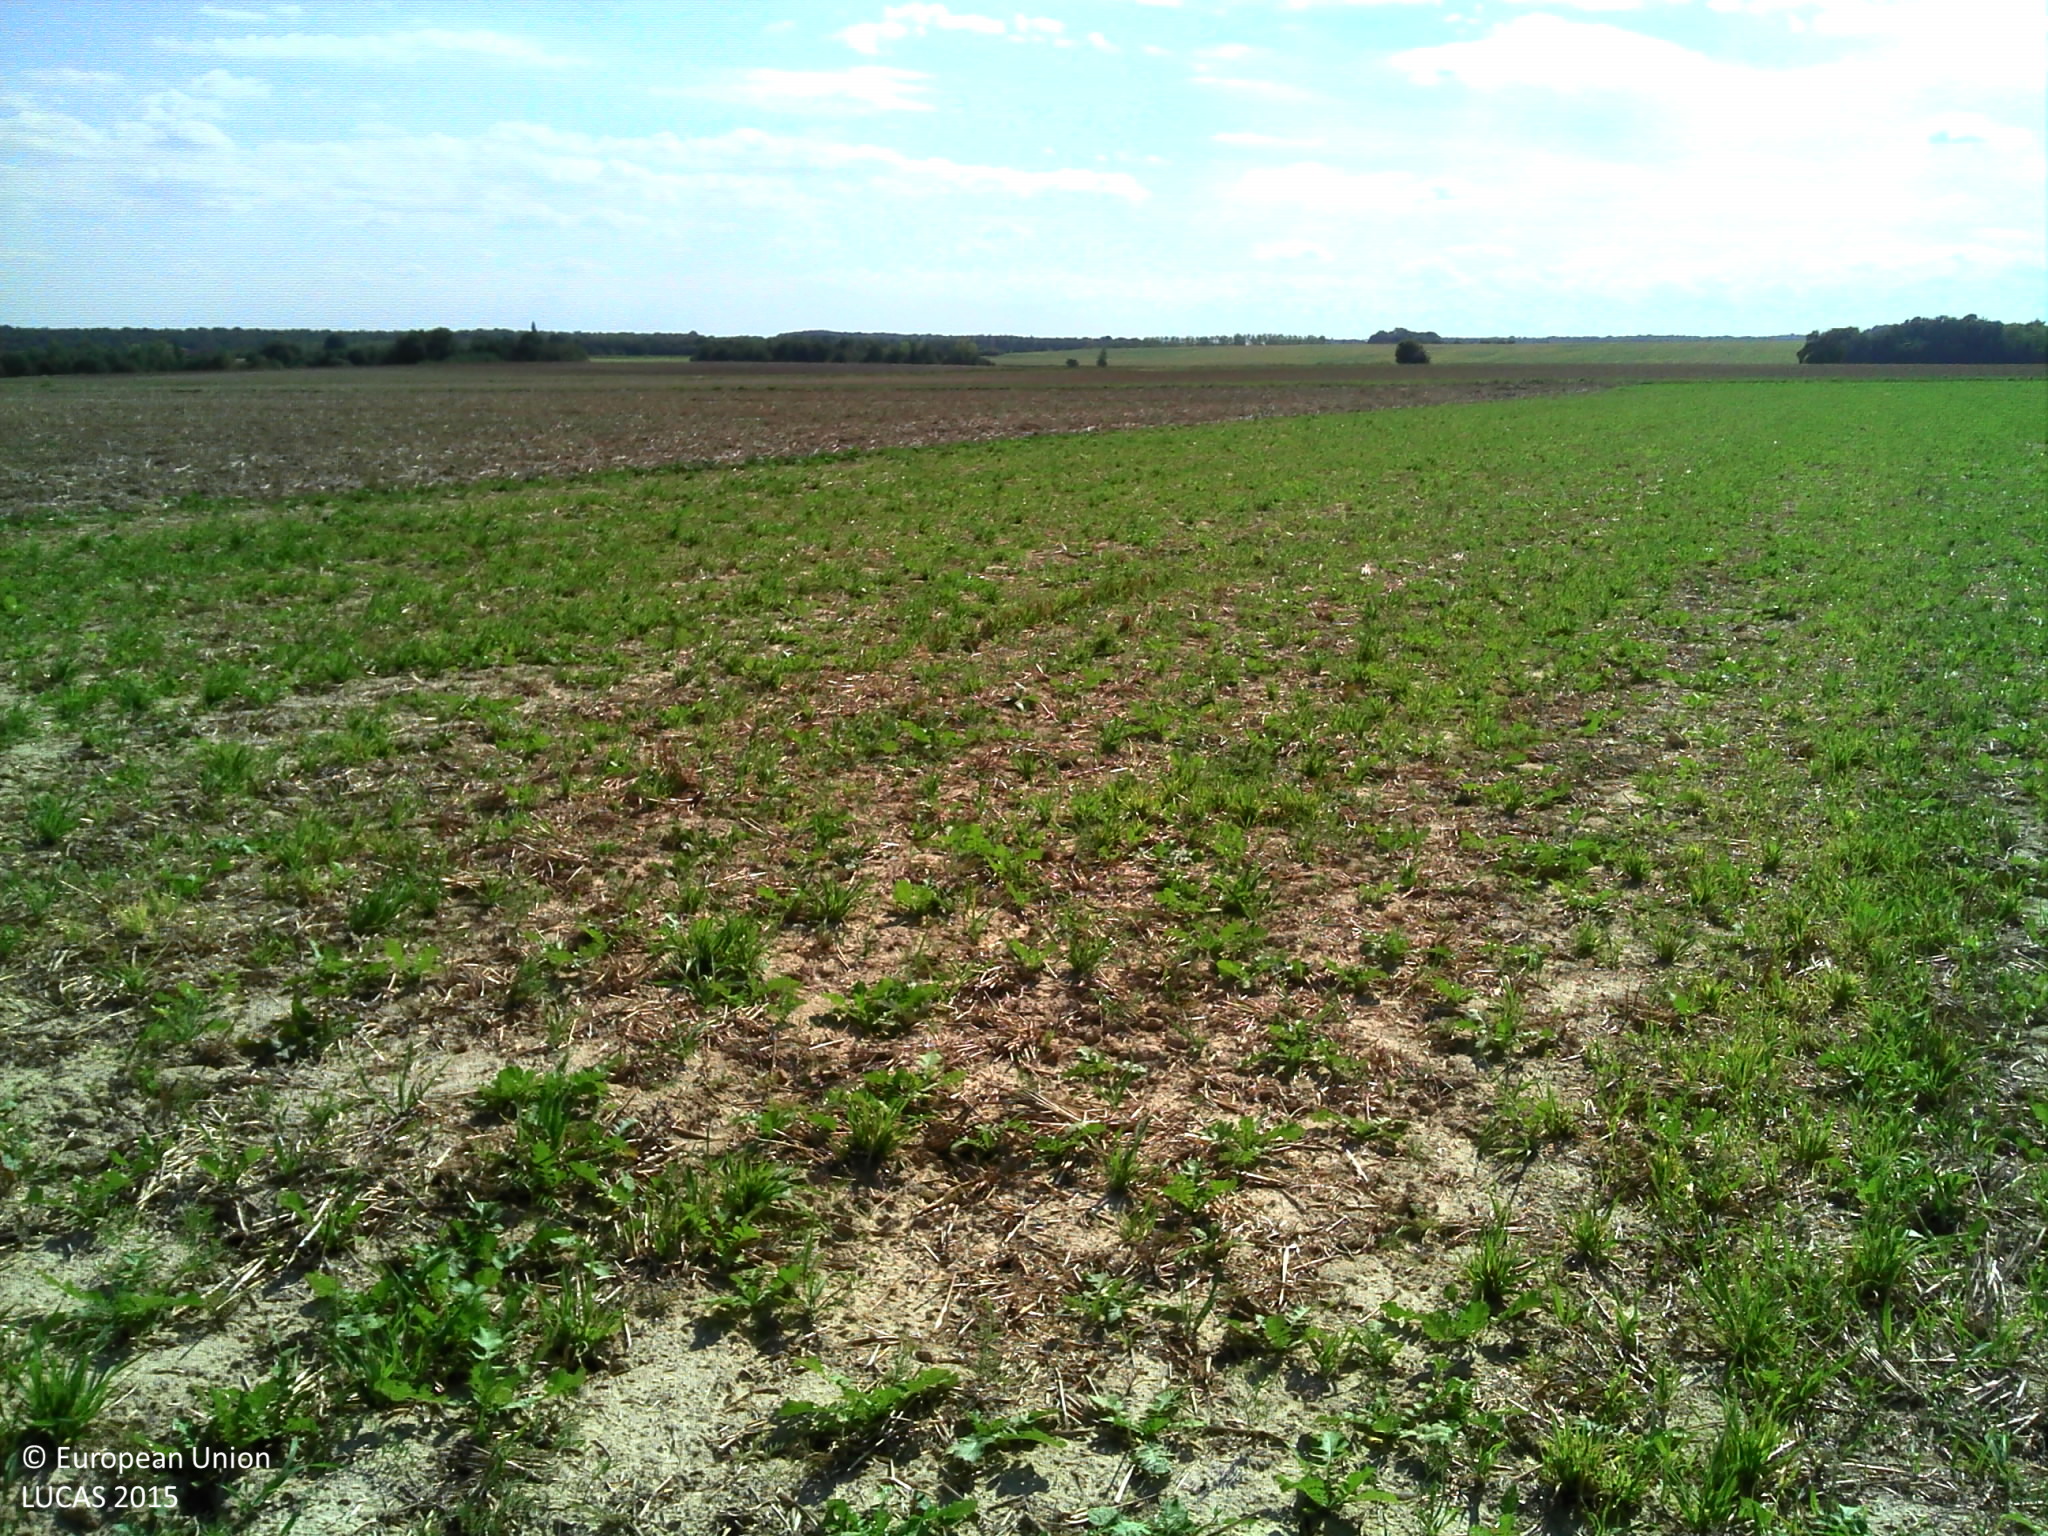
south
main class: Cropland
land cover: Other root crops
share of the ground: < 10 %
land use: Agriculture (excluding fallow land and kitchen gardens)
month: September
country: FR
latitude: 47.1156
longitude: 1.4866
